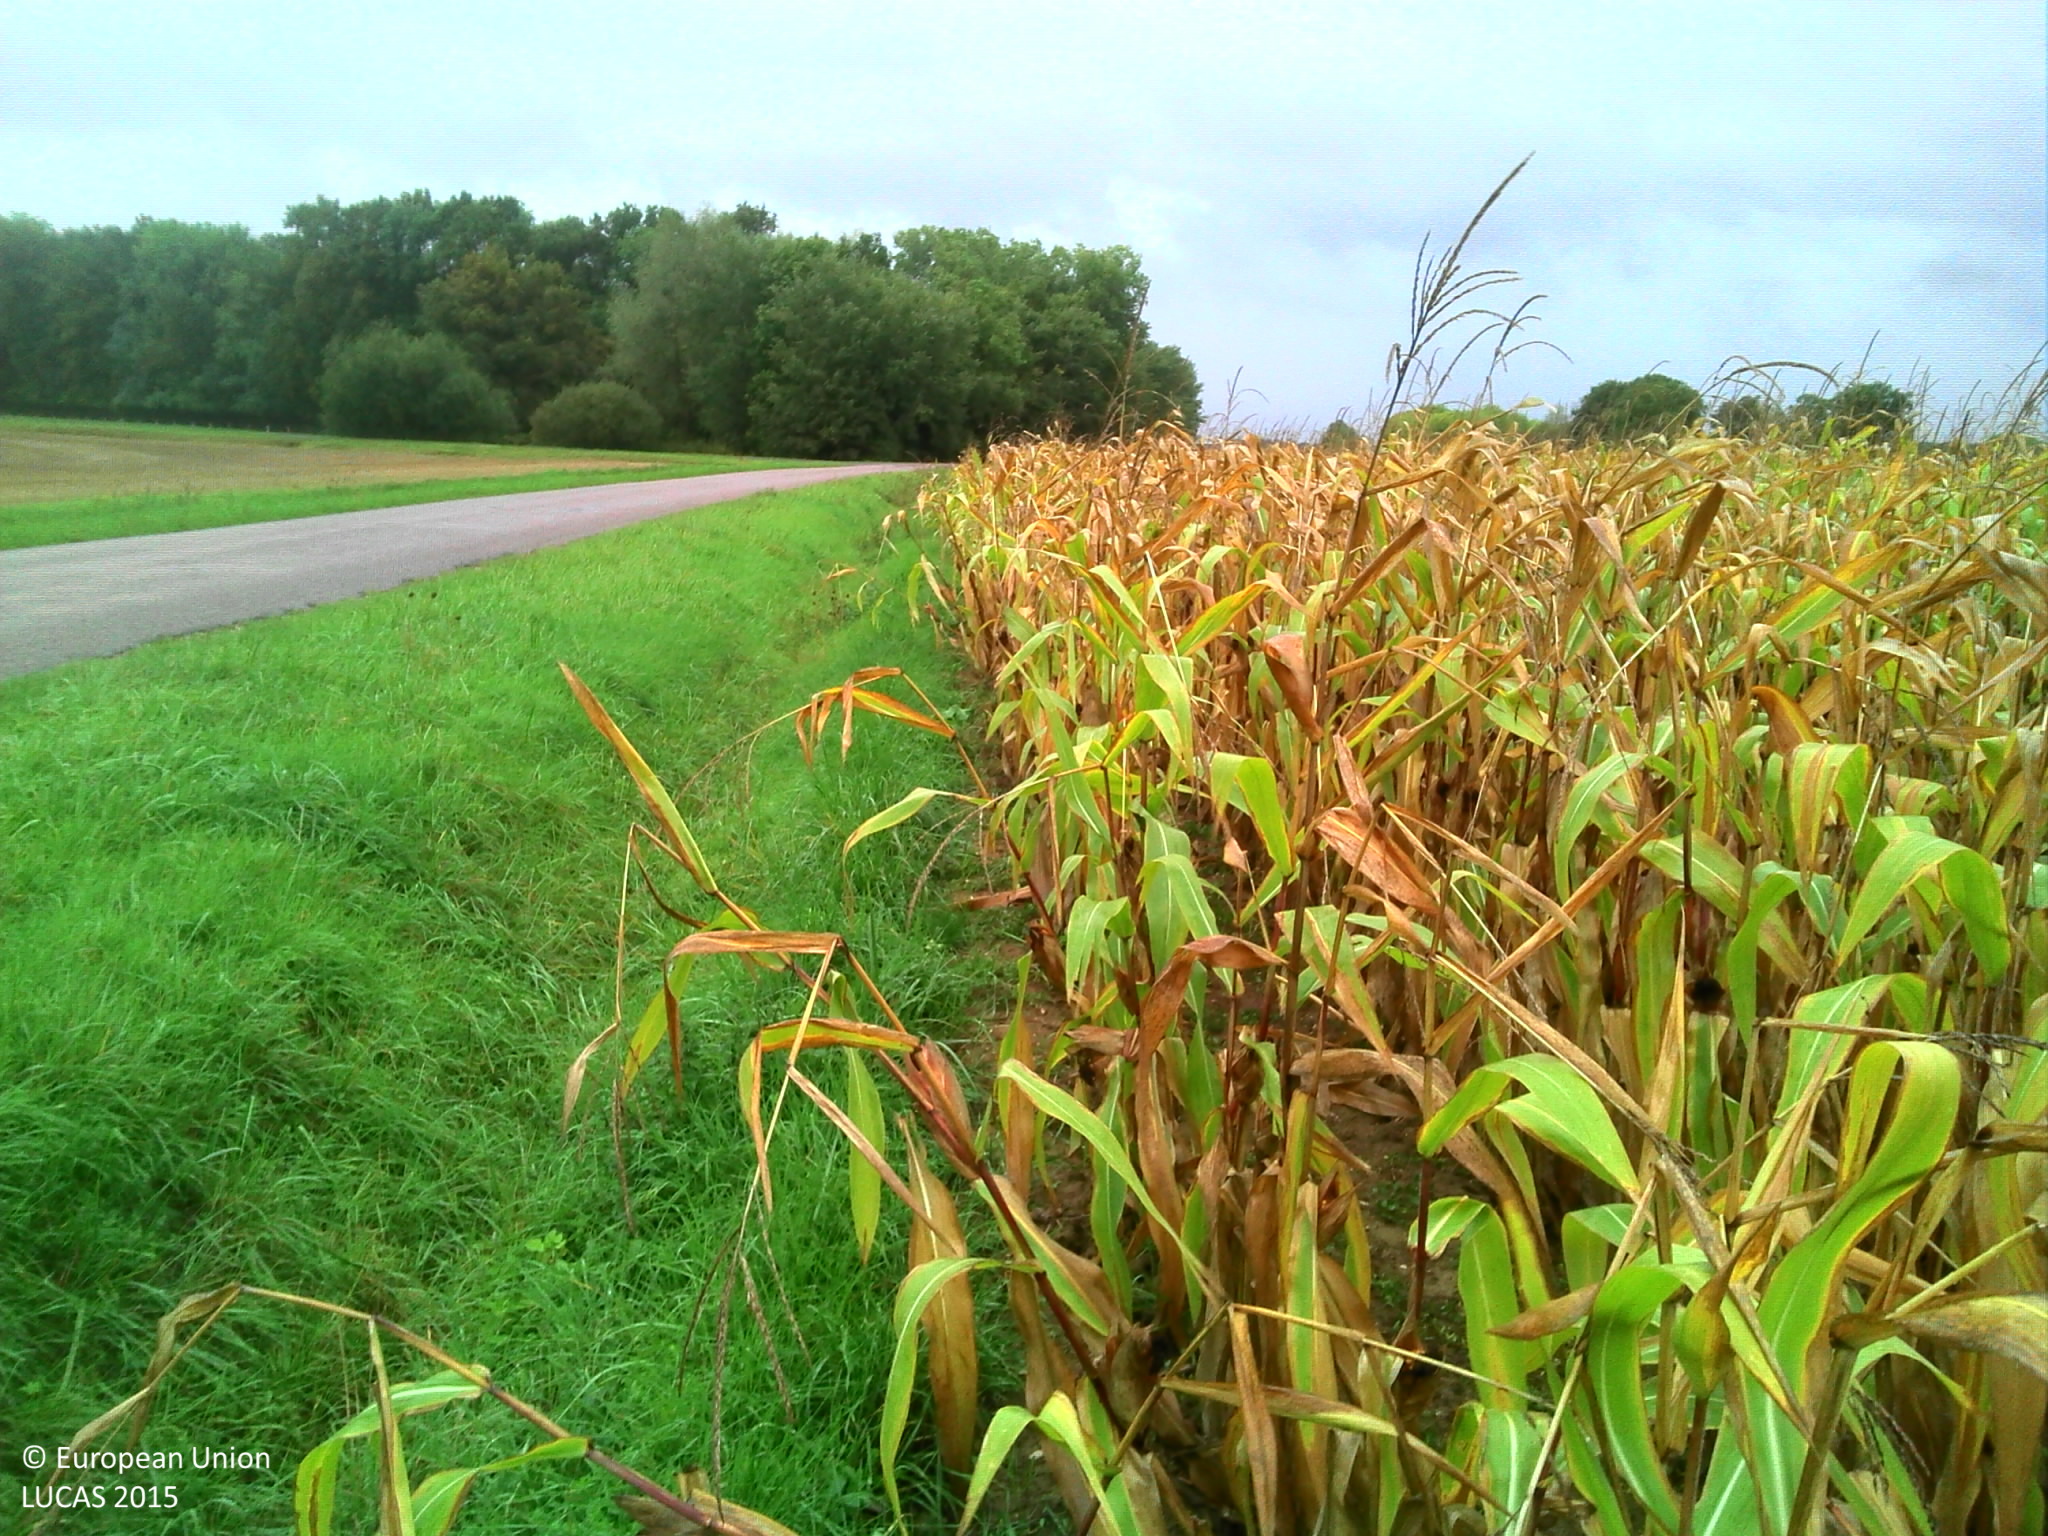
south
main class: Cropland
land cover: Maize
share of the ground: > 75 %
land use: Agriculture (excluding fallow land and kitchen gardens)
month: October
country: FR
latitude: 48.2329
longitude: 4.1942
